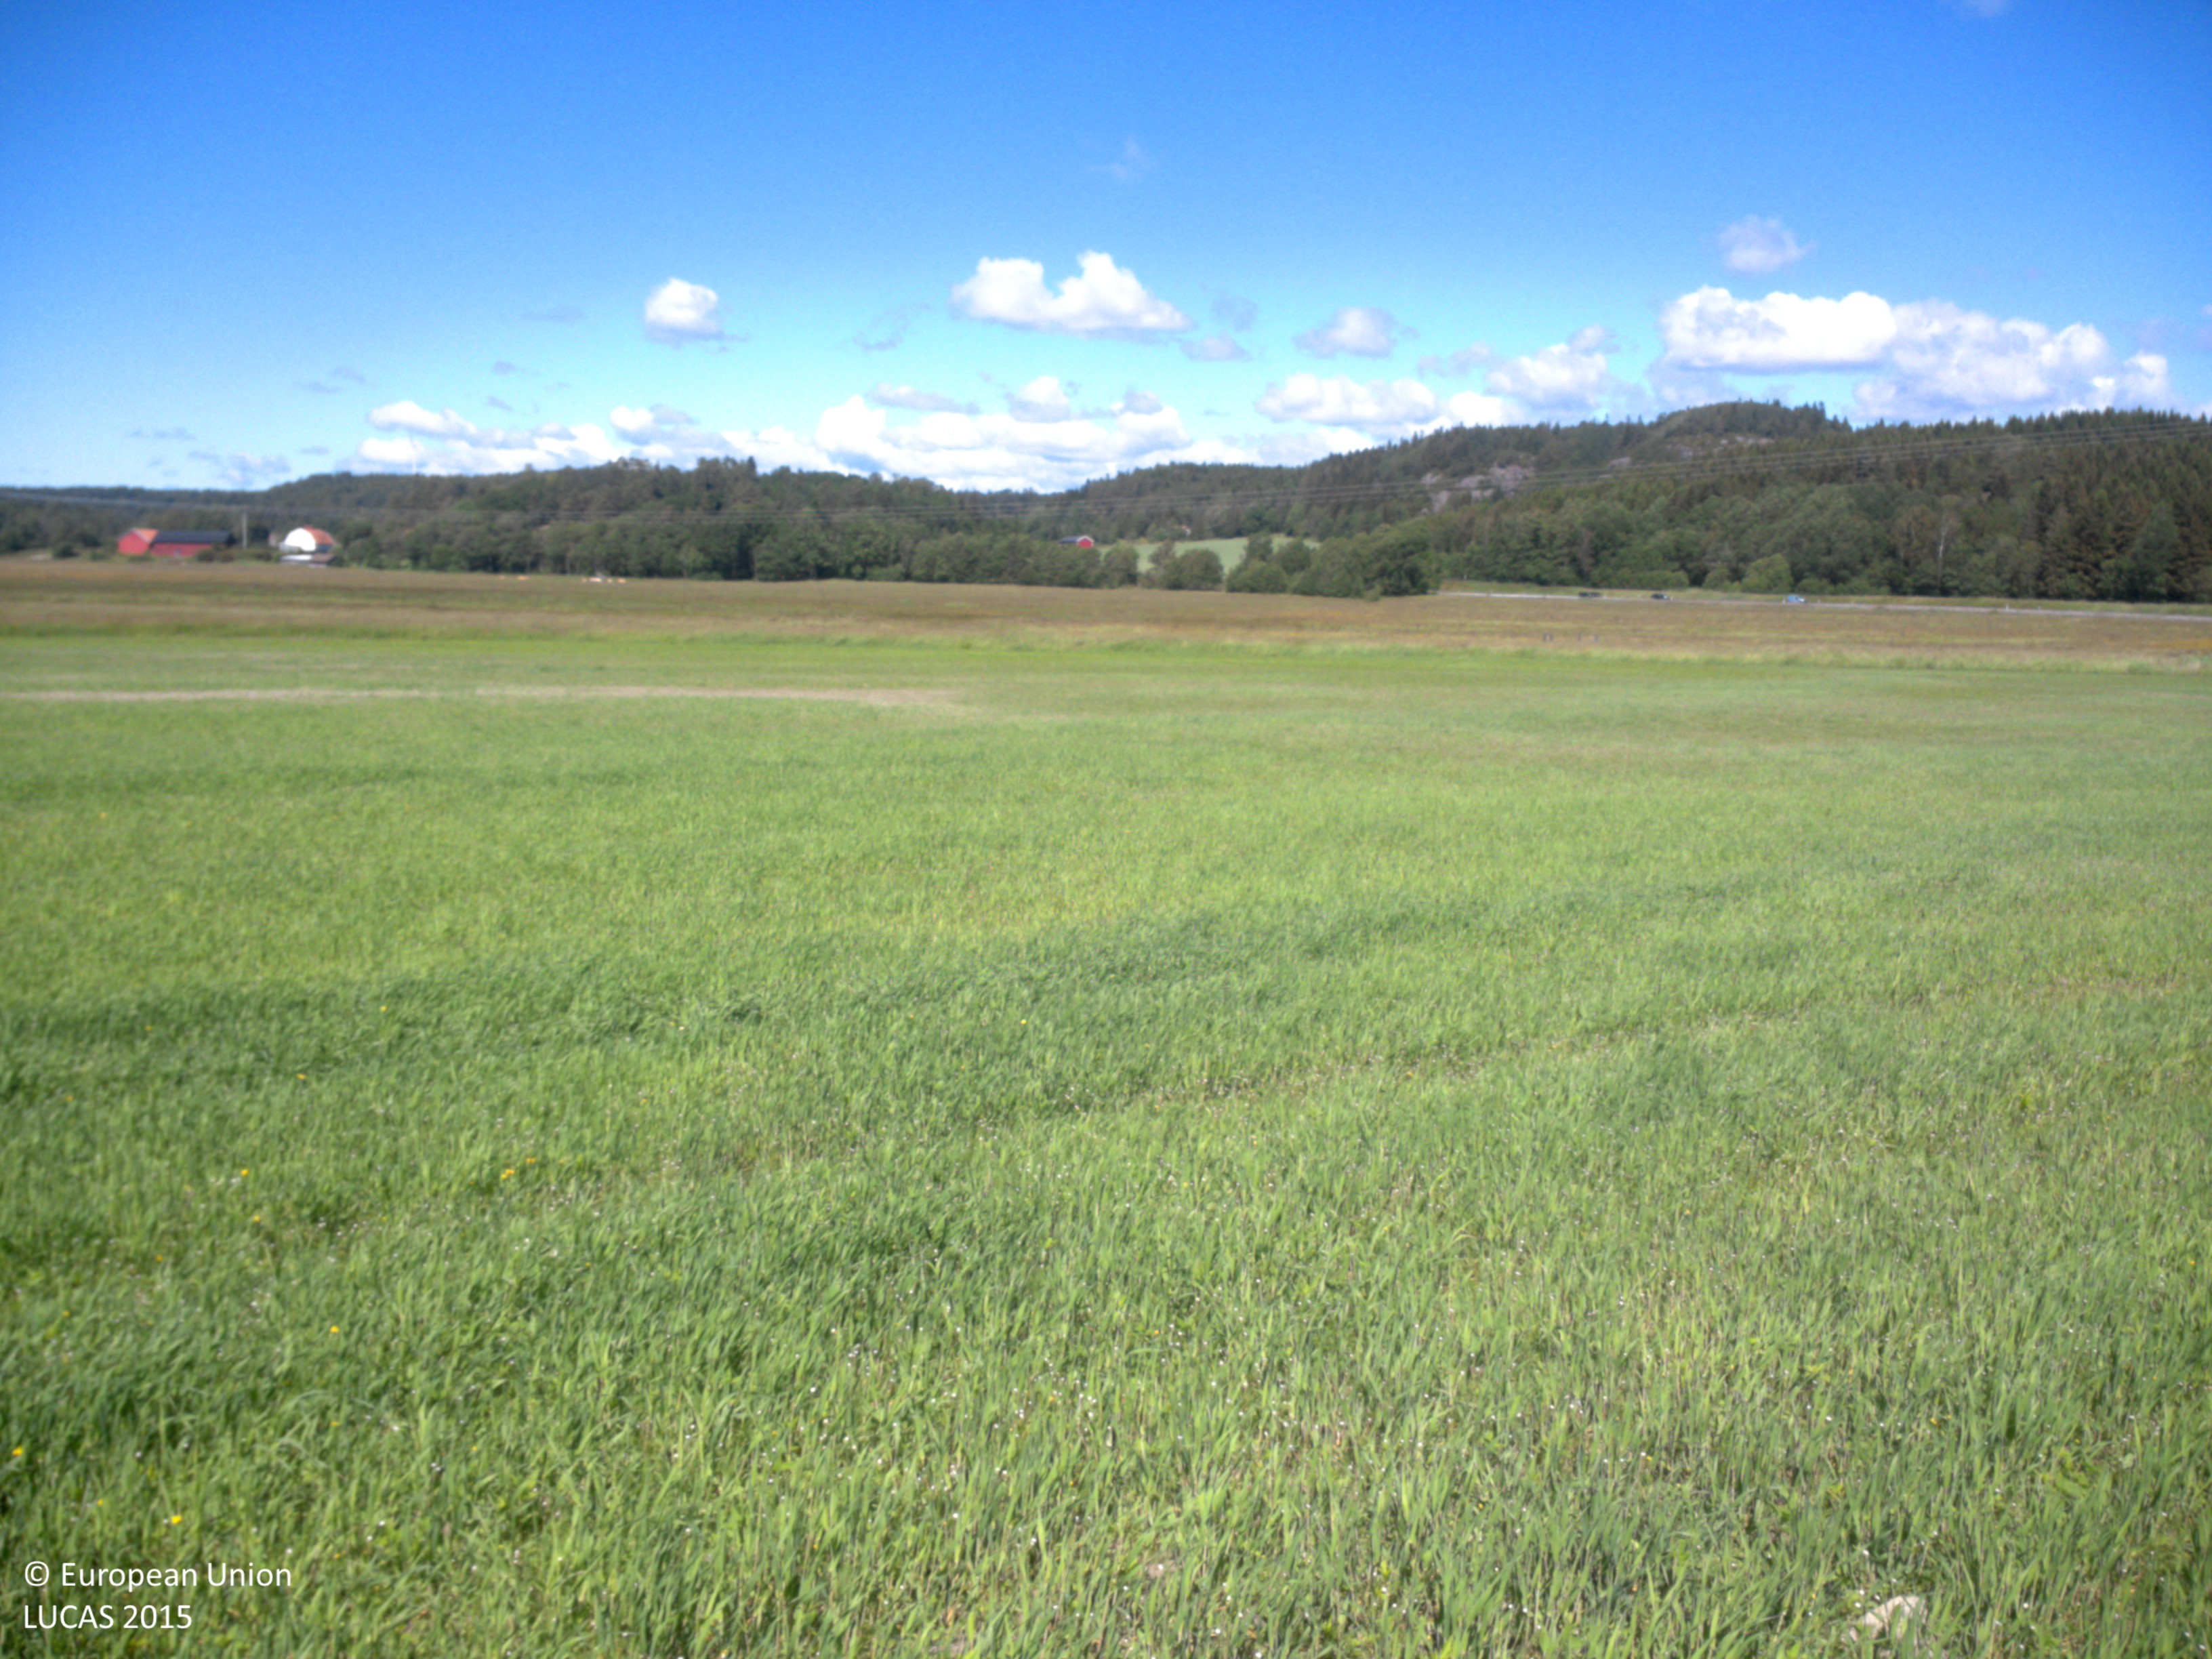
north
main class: Cropland
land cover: Triticale
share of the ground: > 75 %
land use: Agriculture (excluding fallow land and kitchen gardens)
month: June
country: SE
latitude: 58.5346
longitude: 11.5254
